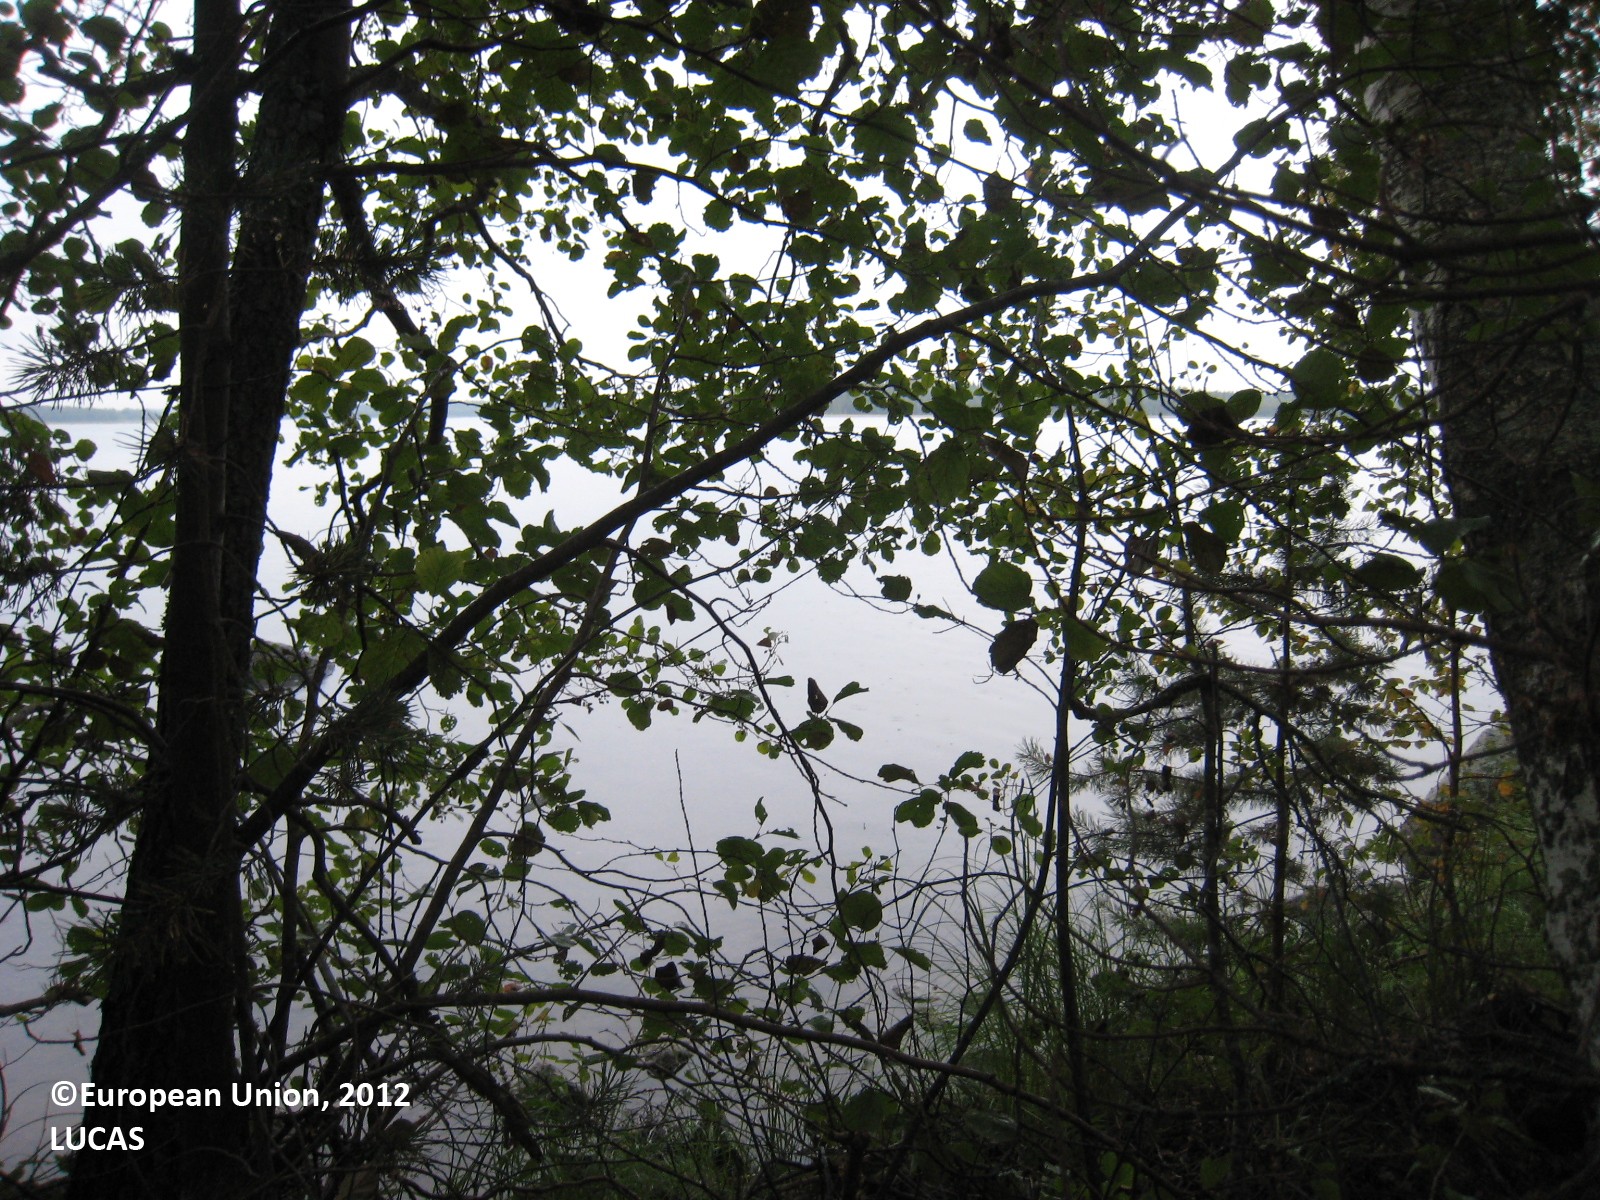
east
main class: Woodland
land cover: Pine dominated mixed woodland
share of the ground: > 75 %
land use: Semi-natural and natural areas not in use
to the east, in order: Pine dominated mixed woodland; Inland water bodies
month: September
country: FI
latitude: 61.6330
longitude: 26.0387
